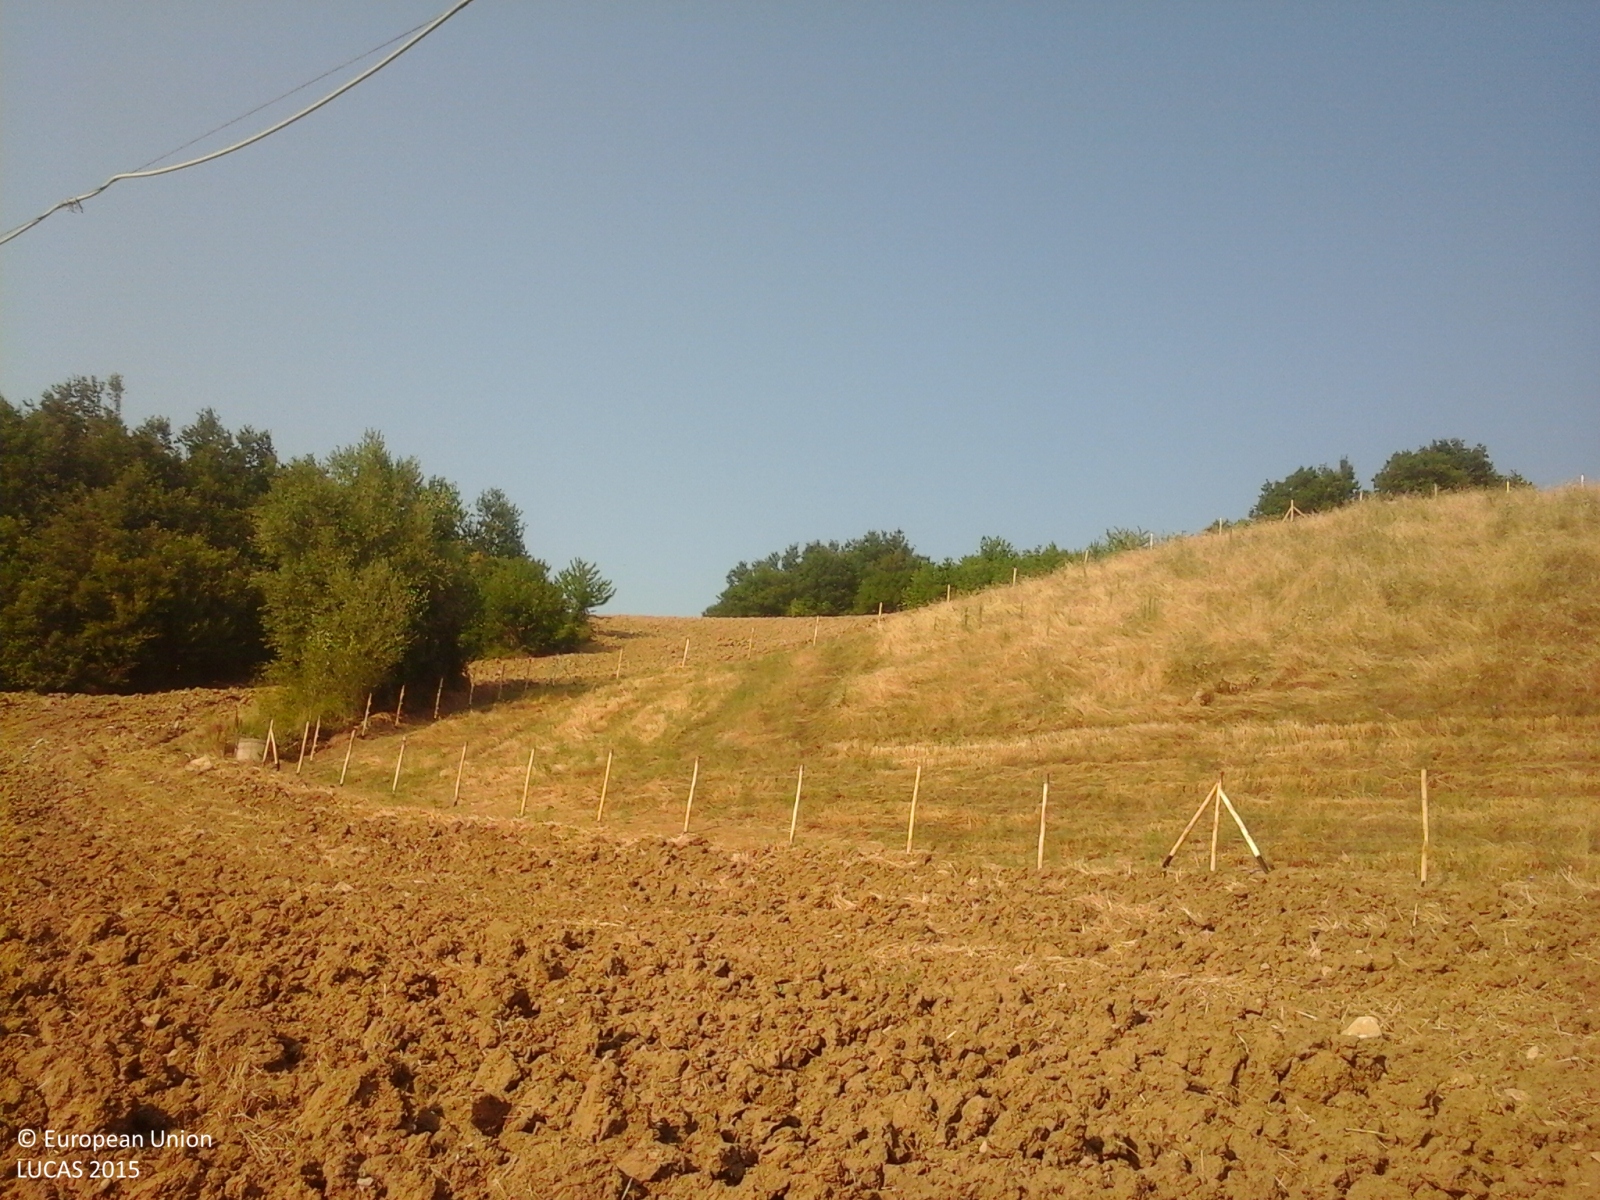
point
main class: Cropland
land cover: Mixed cereals for fodder
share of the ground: > 75 %
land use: Agriculture (excluding fallow land and kitchen gardens)
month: August
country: IT
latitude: 42.4744
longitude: 13.7957
